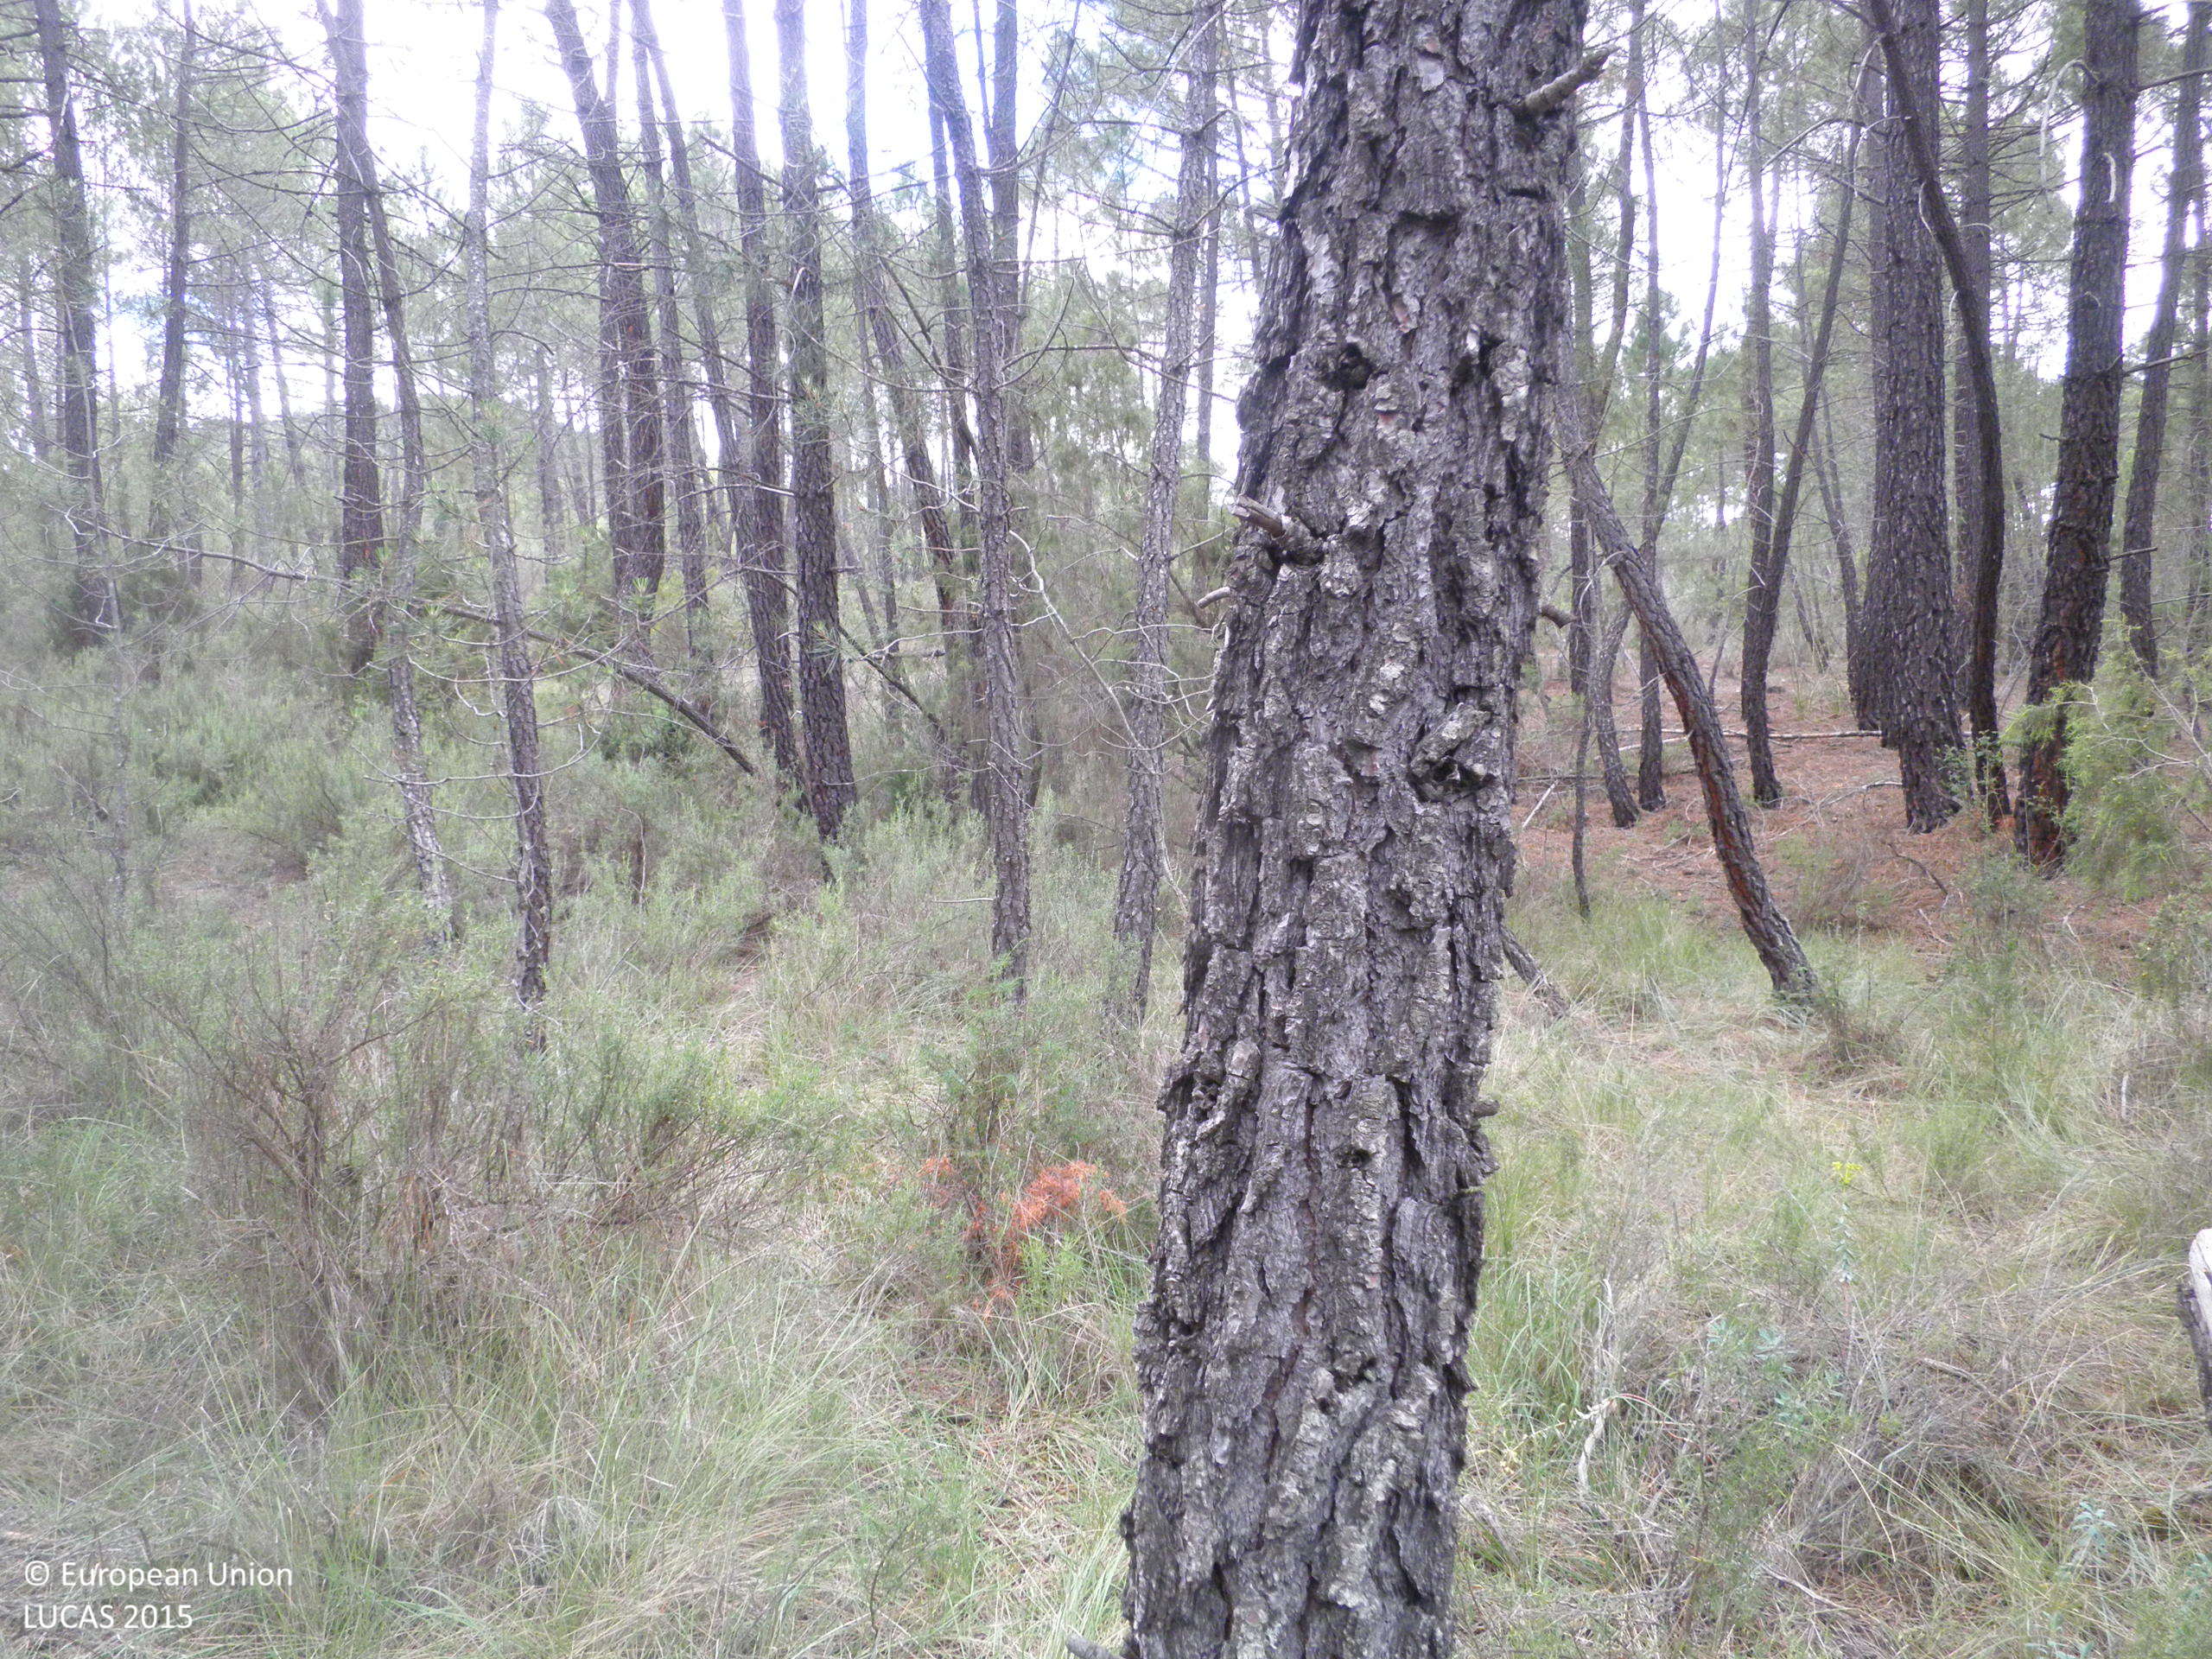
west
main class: Woodland
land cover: Pine dominated coniferous woodland
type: coniferous forest of the mediterranean region
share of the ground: 50 - 75 %
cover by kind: coniferous forest trees 60 %, herbaceous plants 20 %, shrubs 10 %, consolidated bare surface 10 %
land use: Semi-natural and natural areas not in use
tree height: > 5 m
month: June
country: ES
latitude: 39.7898
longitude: -1.6510
